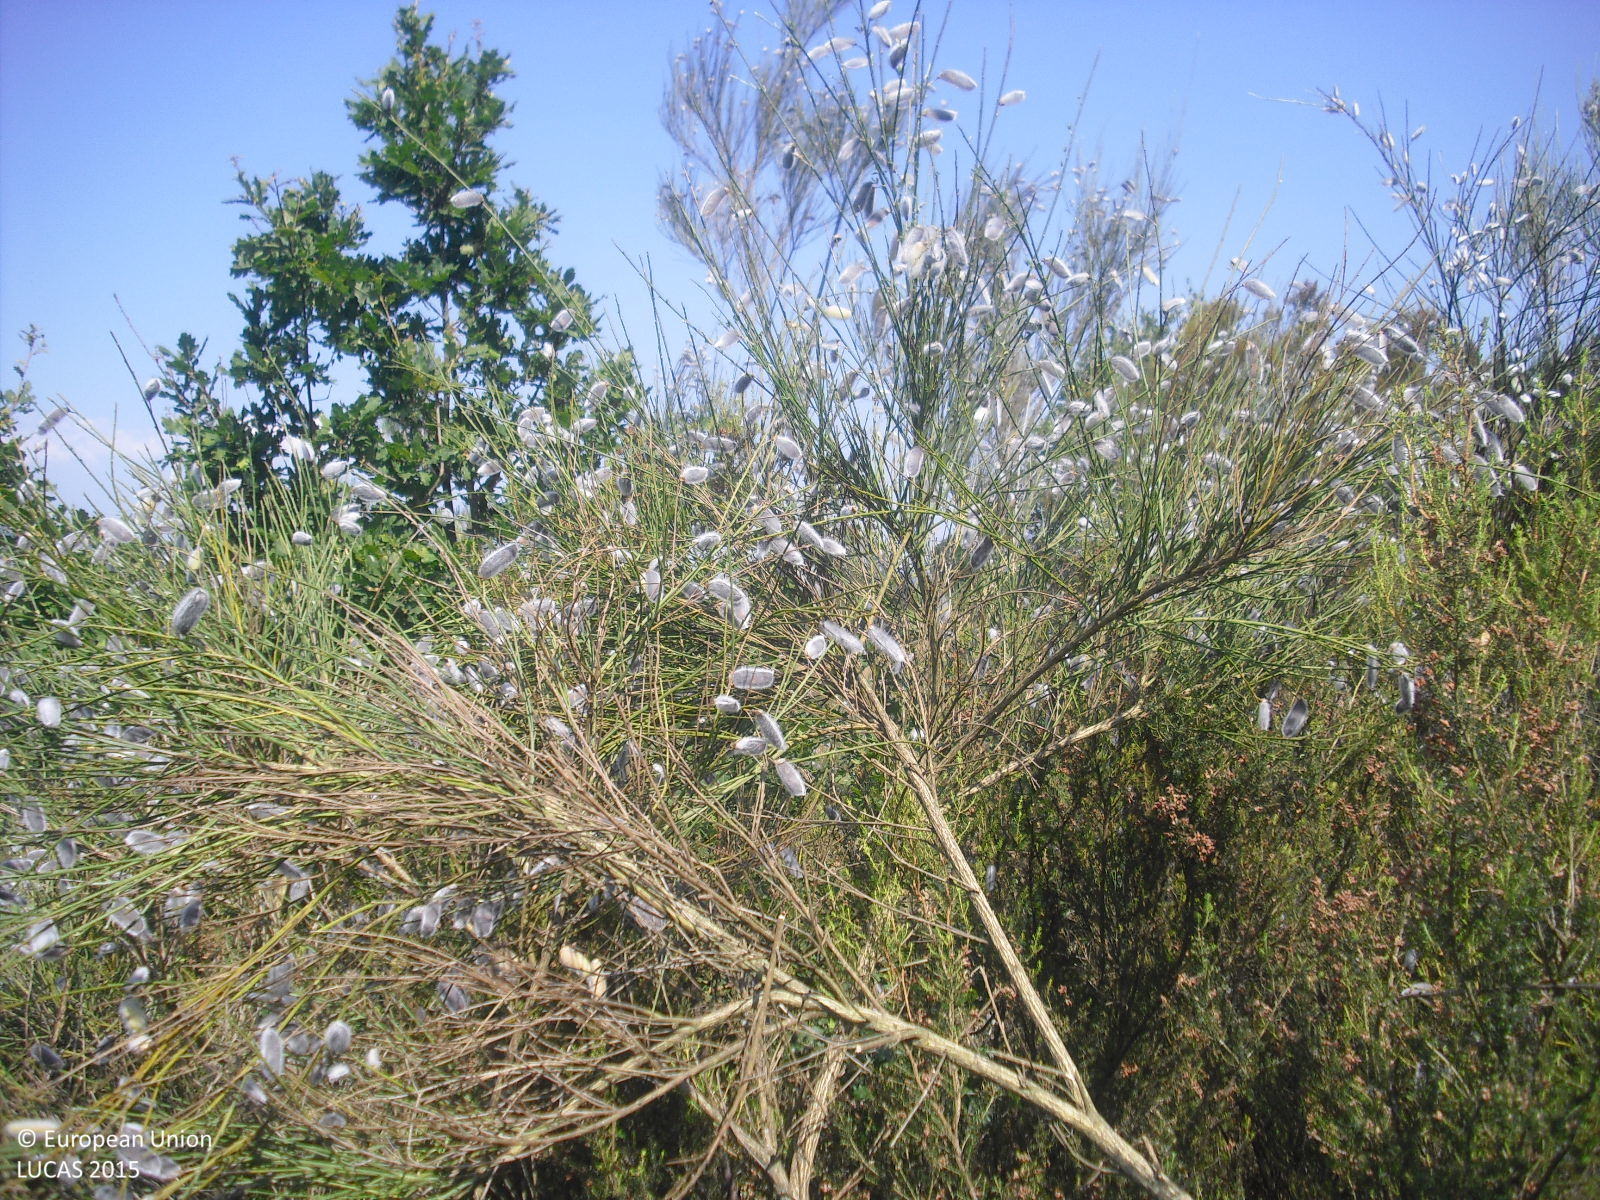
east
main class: Shrubland
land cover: Shrubland with sparse tree cover
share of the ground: > 75 %
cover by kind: shrubs 95 %, broadleaved forest trees 5 %
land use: Forestry
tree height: < 5 m
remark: Clear cut
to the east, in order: Shrubland with sparse tree cover; Shrubland without tree cover; Shrubland with sparse tree cover; Grassland with sparse tree/shrub cover; Shrubland without tree cover; Tracks; Shrubland without tree cover; Single bushes/trees; Shrubland without tree cover; Grassland with sparse tree/shrub cover; Shrubland with sparse tree cover; Shrubland without tree cover
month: July
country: ES
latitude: 42.4537
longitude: -7.4430
